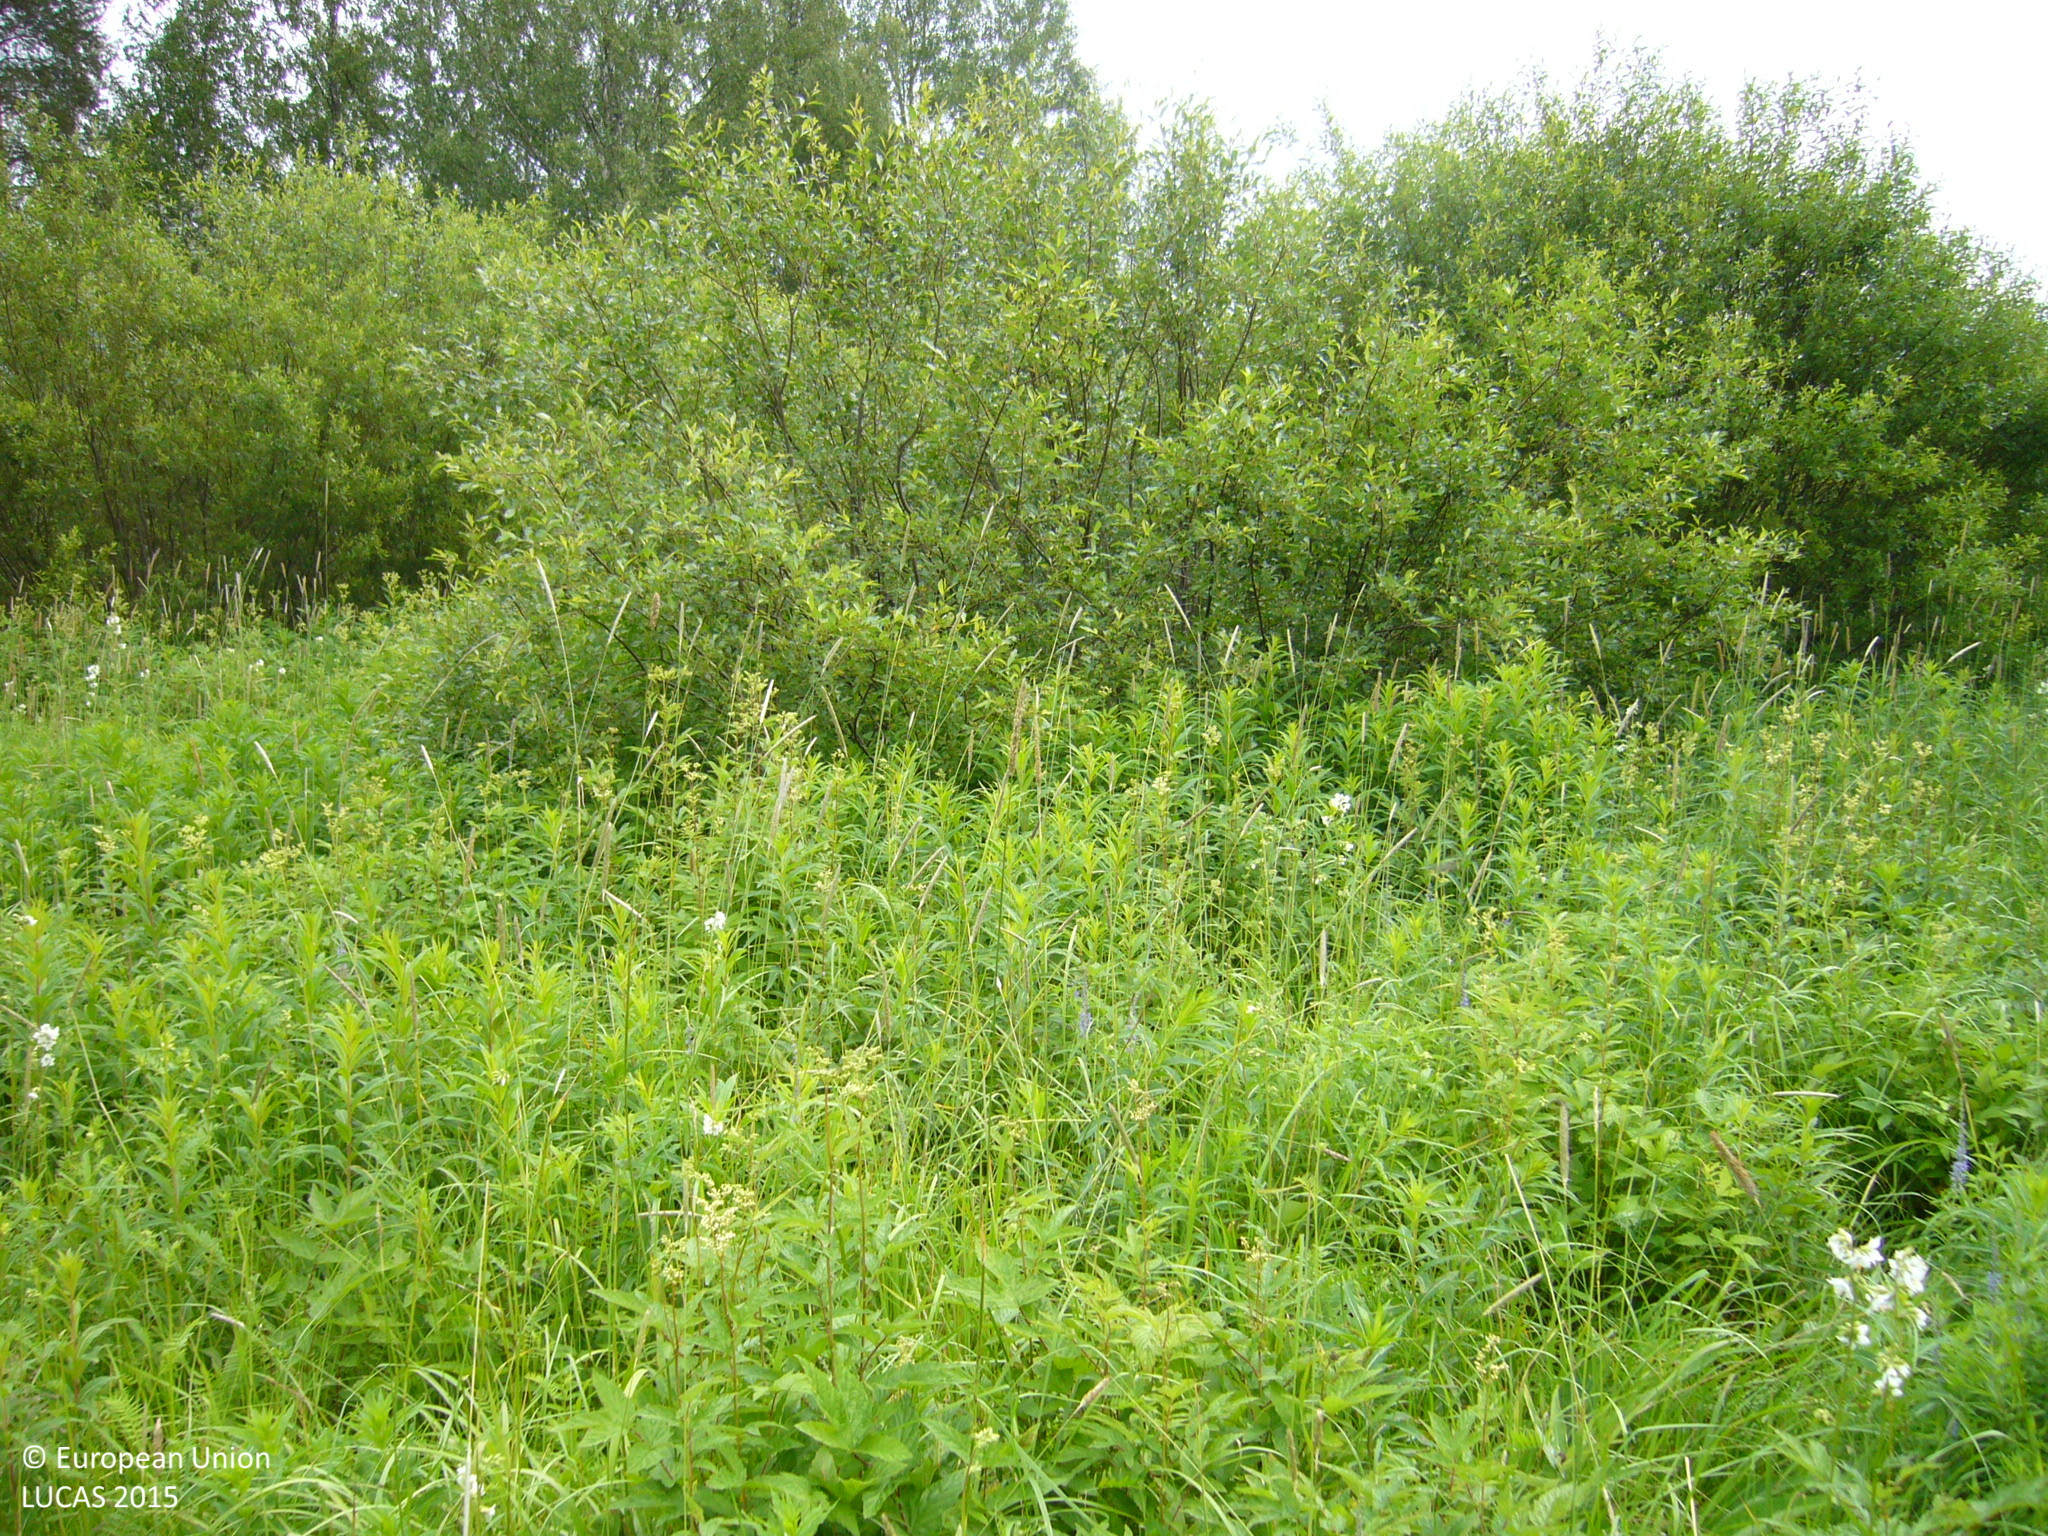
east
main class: Grassland
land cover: Spontaneously vegetated surfaces
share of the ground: > 75 %
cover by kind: herbaceous plants 100 %
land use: Fallow land
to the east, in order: Spontaneously vegetated surfaces; Ditches and canals; Broadleaved woodland; Spontaneously vegetated surfaces; Ditches and canals; Broadleaved woodland; Spontaneously vegetated surfaces; Ditches and canals; Spruce dominated mixed woodland; Grassland without tree/shrub cover; Artificial constructions in urban areas; Grassland without tree/shrub cover; Broadleaved woodland; Ditches and canals; Spontaneously vegetated surfaces; Ditches and canals; Spontaneously vegetated surfaces; Ditches and canals; Broadleaved woodland; Other mixed woodland; Ditches and canals; Spontaneously vegetated surfaces; Ditches and canals; Broadleaved woodland; Spruce dominated mixed woodland
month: July
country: FI
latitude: 63.7606
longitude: 25.4851
